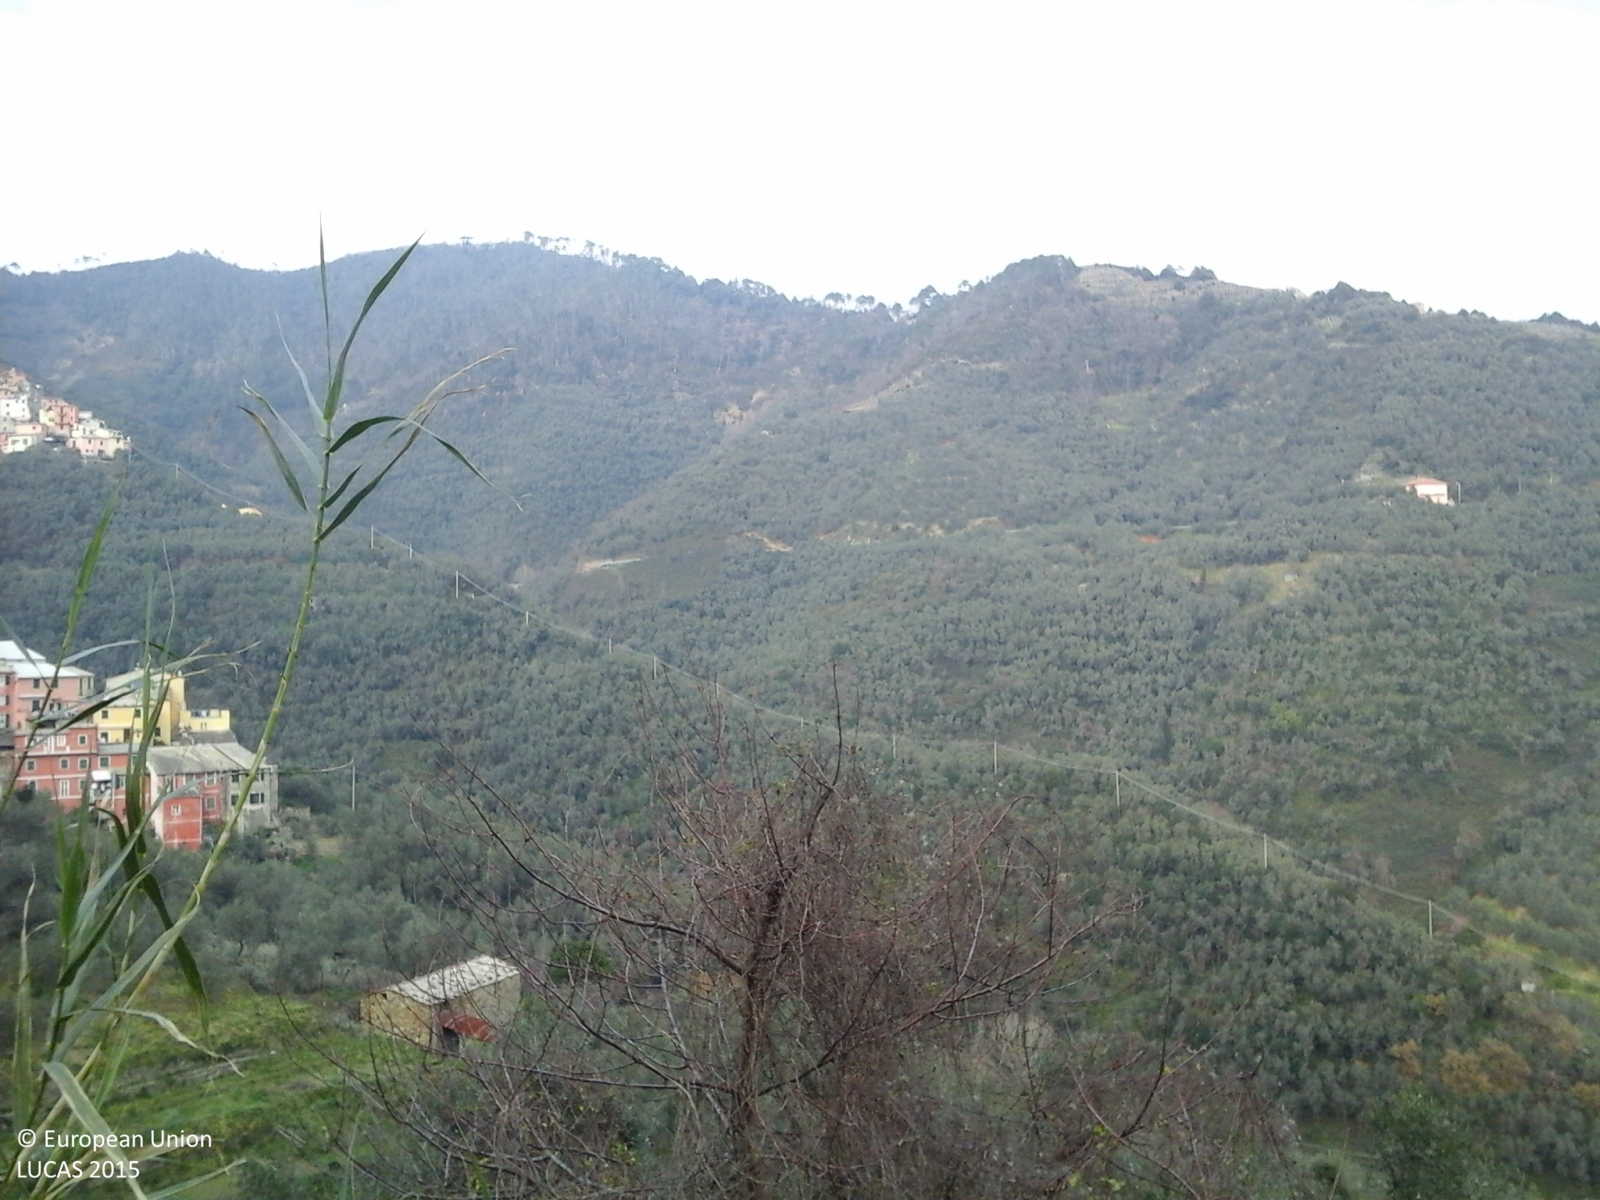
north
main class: Woodland
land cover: Broadleaved woodland
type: thermophilous deciduous forest
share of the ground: > 75 %
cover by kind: broadleaved forest trees 75 %, coniferous forest trees 10 %, shrubs 10 %, herbaceous plants 5 %
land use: Forestry
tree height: > 5 m
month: October
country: IT
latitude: 44.1875
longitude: 9.6131
